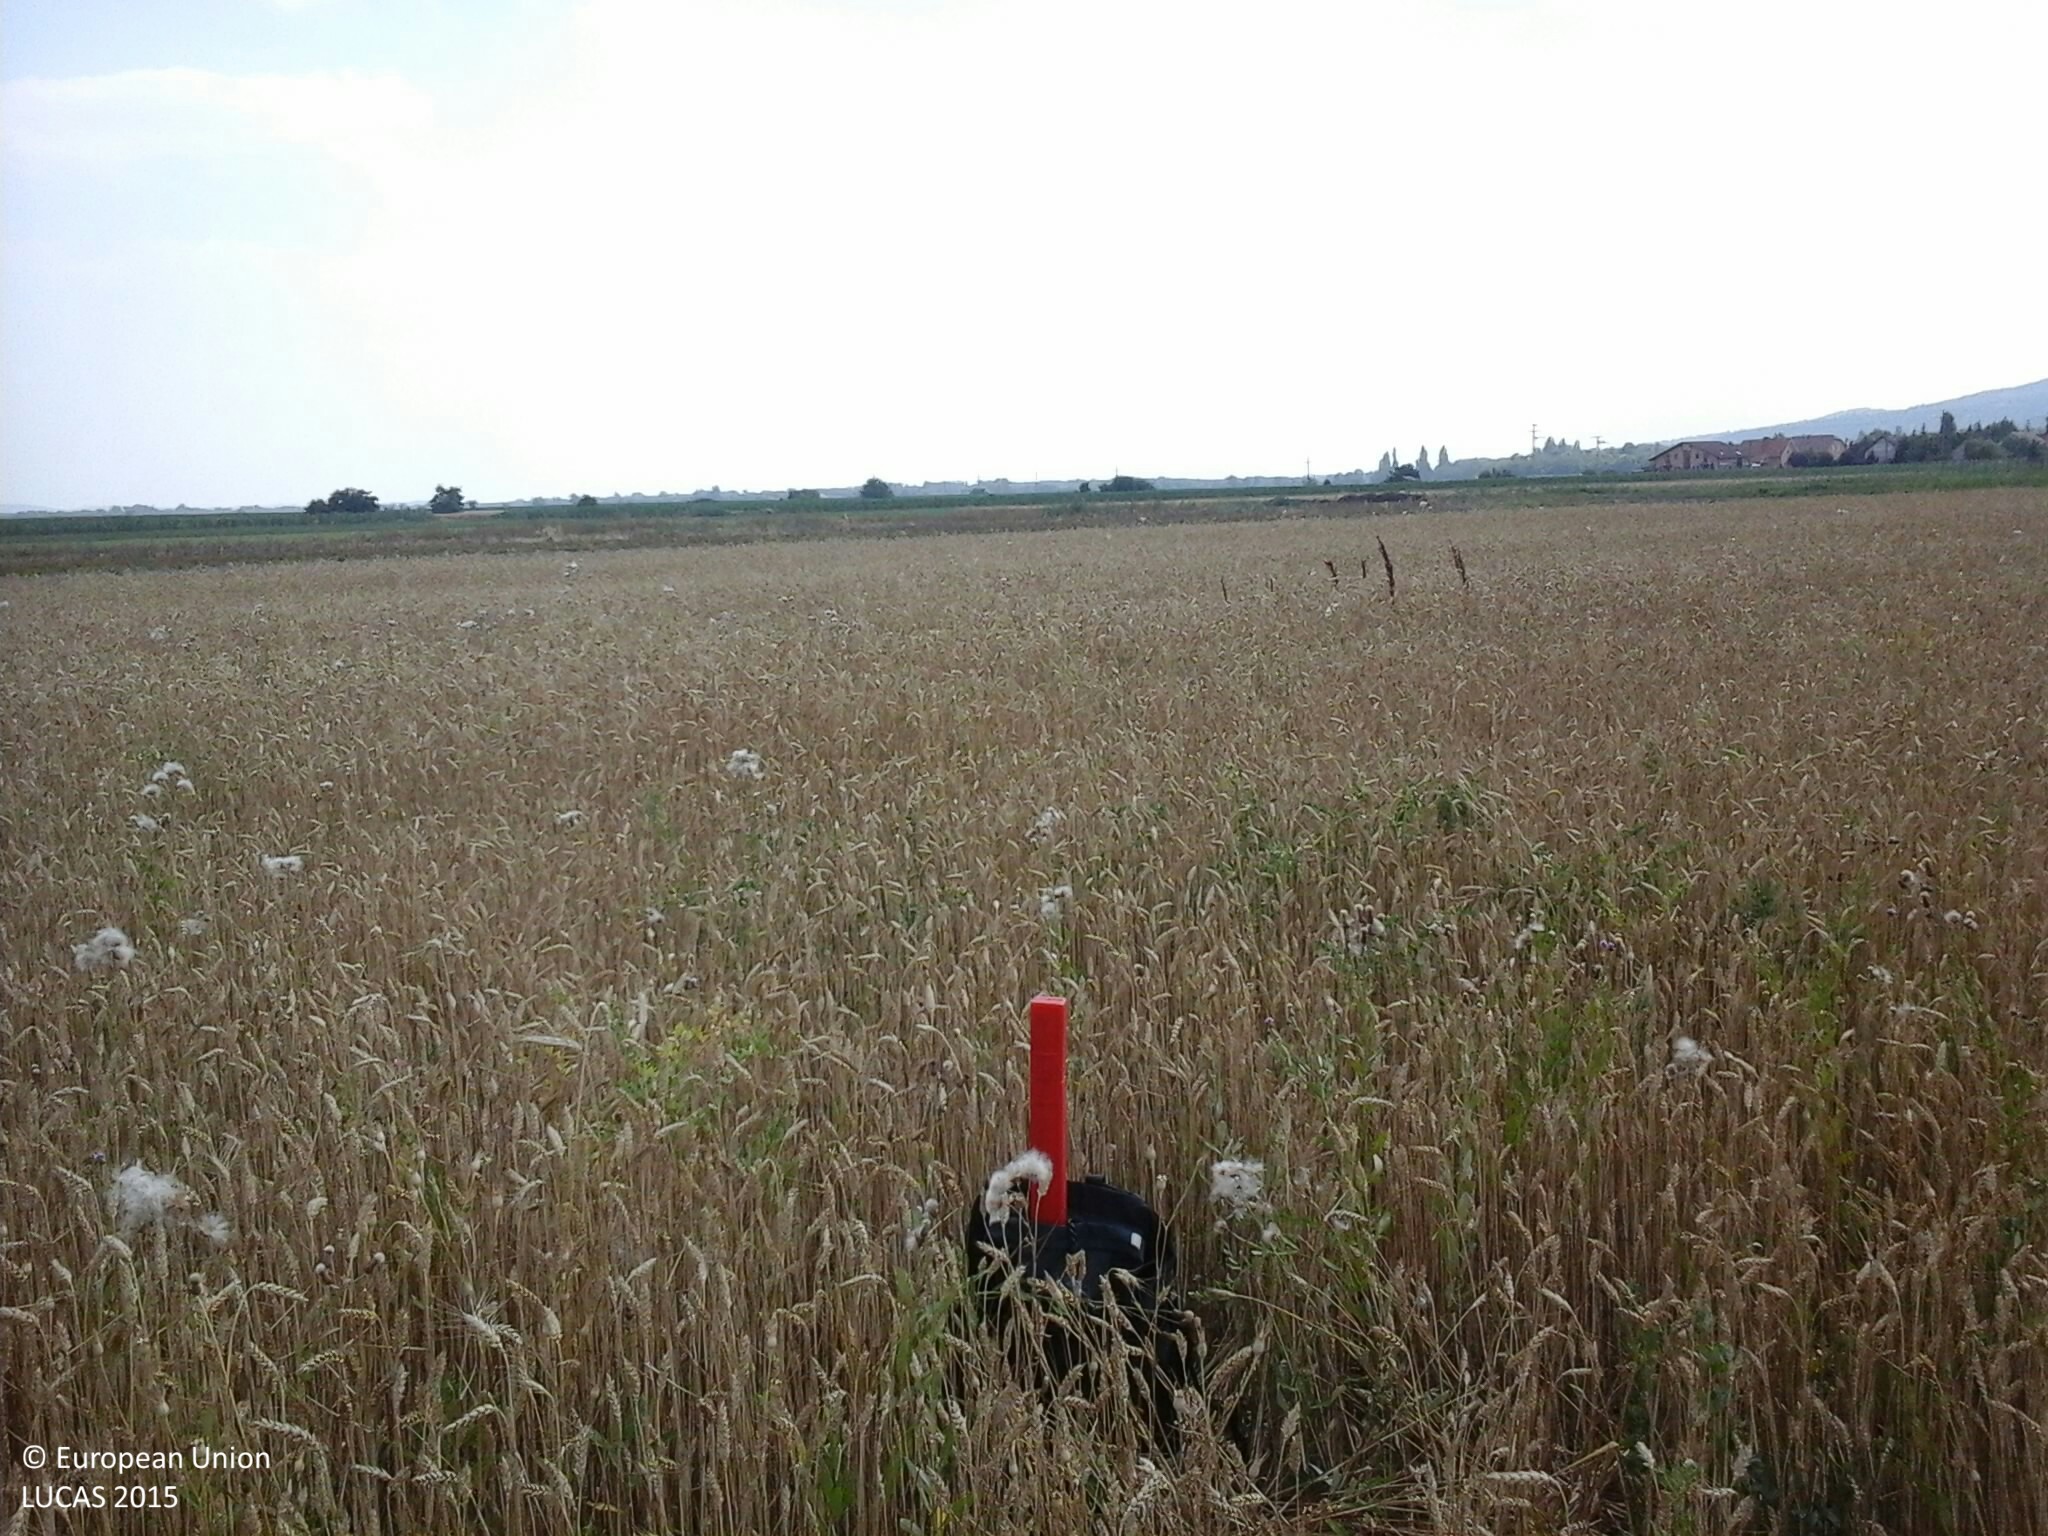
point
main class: Cropland
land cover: Common wheat
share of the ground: > 75 %
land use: Agriculture (excluding fallow land and kitchen gardens)
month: July
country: HU
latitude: 47.7557
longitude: 19.1036
